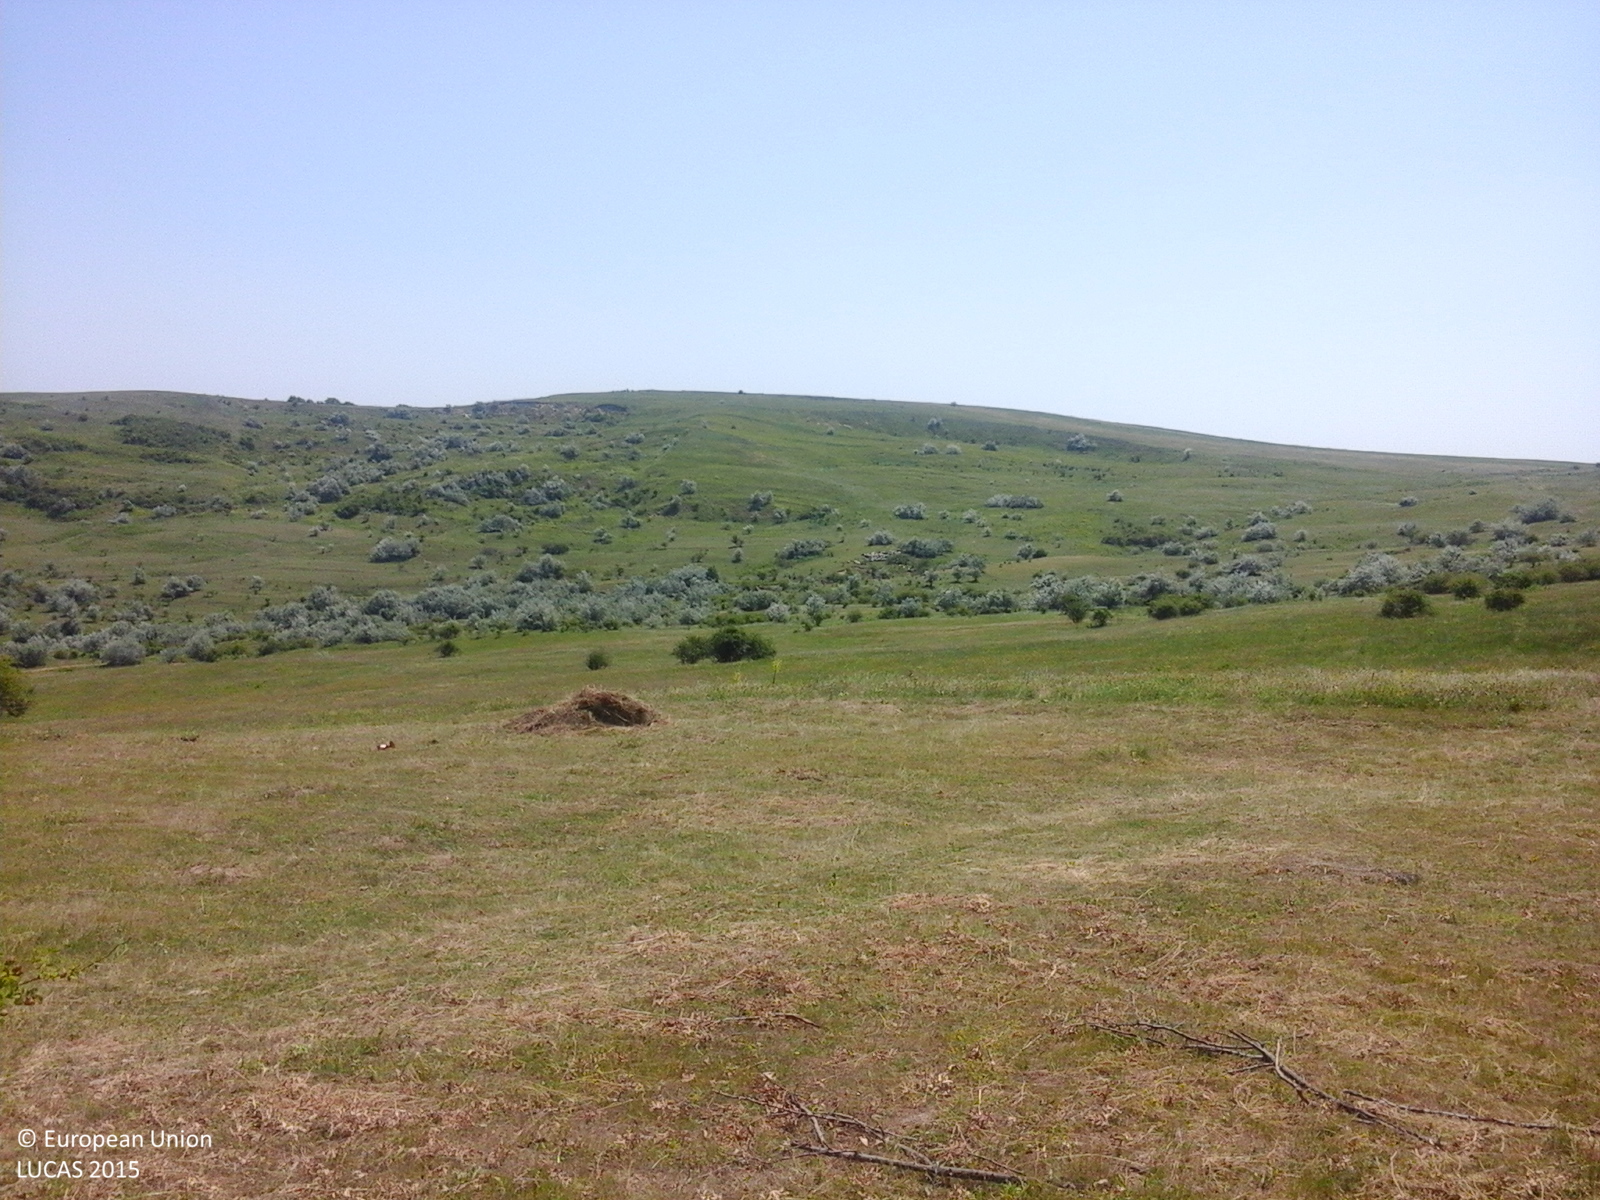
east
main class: Grassland
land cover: Grassland with sparse tree/shrub cover
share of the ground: > 75 %
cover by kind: herbaceous plants 90 %, broadleaved forest trees 5 %, shrubs 5 %
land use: Agriculture (excluding fallow land and kitchen gardens)
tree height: < 5 m
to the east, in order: Grassland with sparse tree/shrub cover; Tracks; Grassland with sparse tree/shrub cover
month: June
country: RO
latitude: 46.7429
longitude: 27.4536
